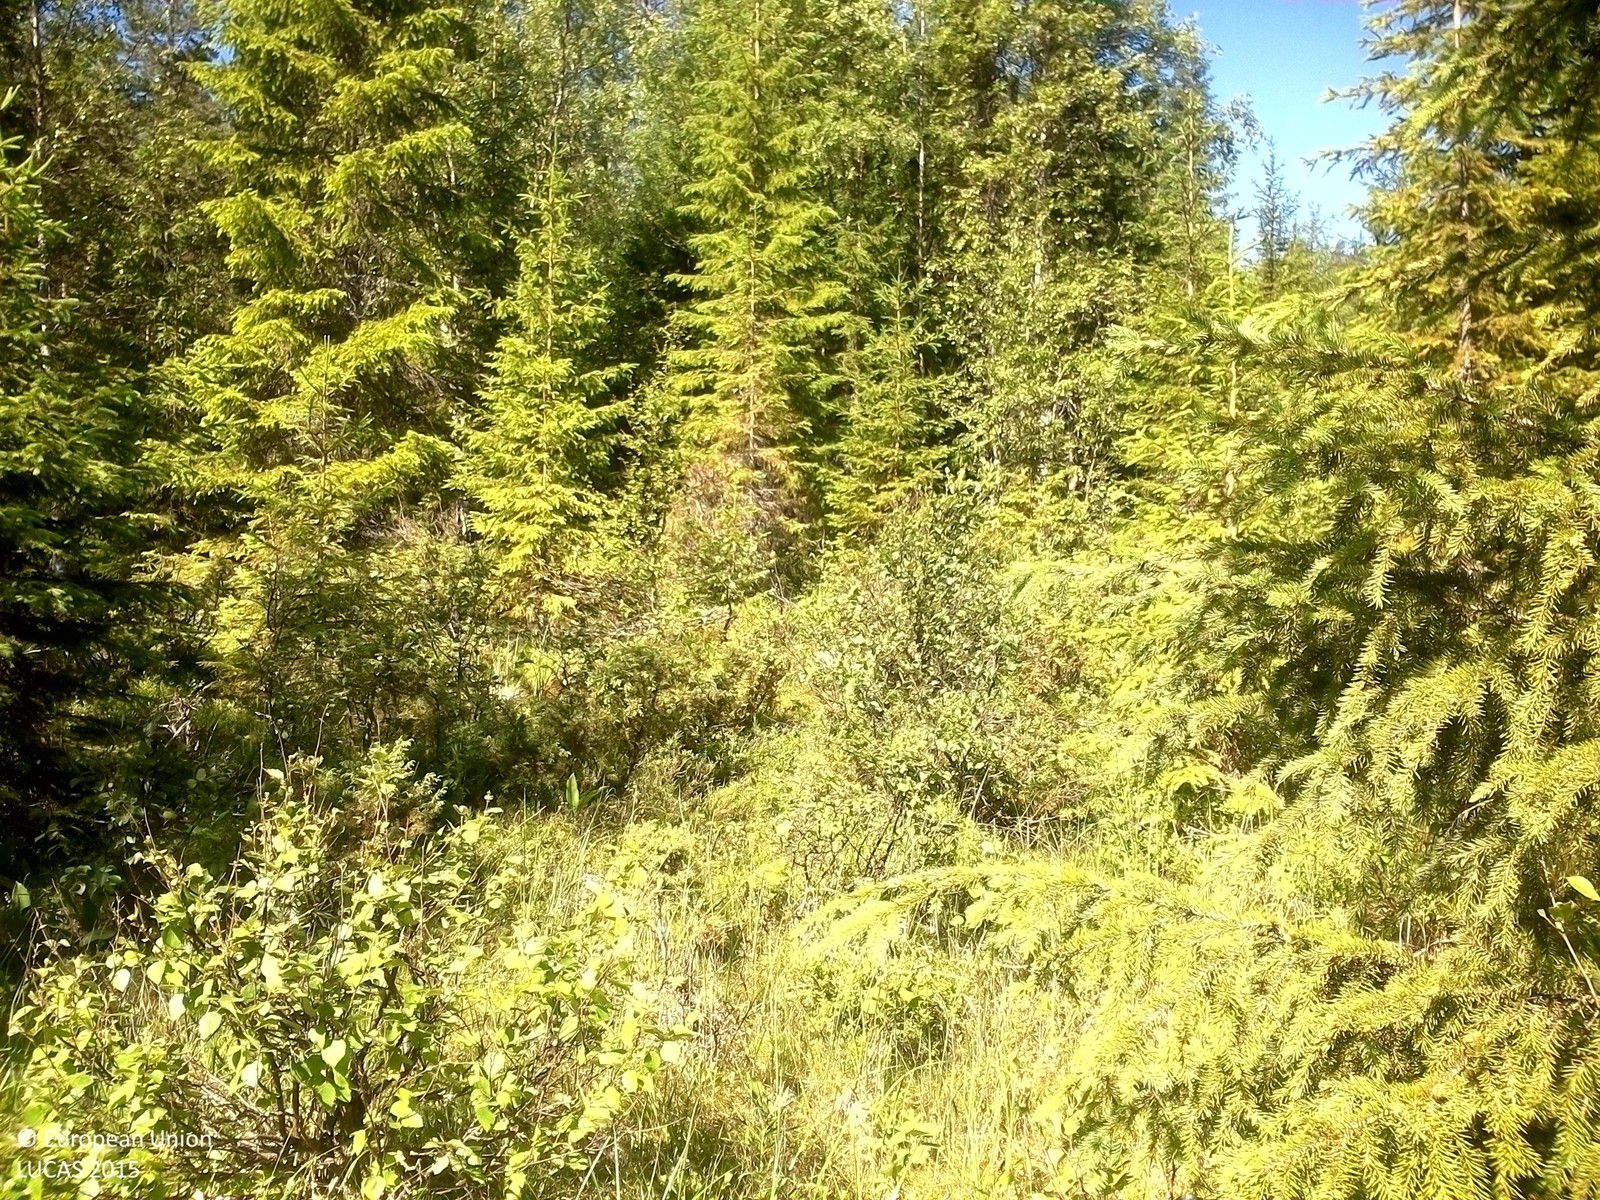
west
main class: Woodland
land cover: Spruce dominated coniferous woodland
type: boreal forest
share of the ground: 25 - 50 %
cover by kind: coniferous forest trees 40 %, herbaceous plants 30 %, shrubs 15 %, lichens and mosses 10 %, broadleaved forest trees 5 %
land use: Forestry
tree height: > 5 m
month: July
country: SE
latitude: 62.8007
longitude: 17.6069
